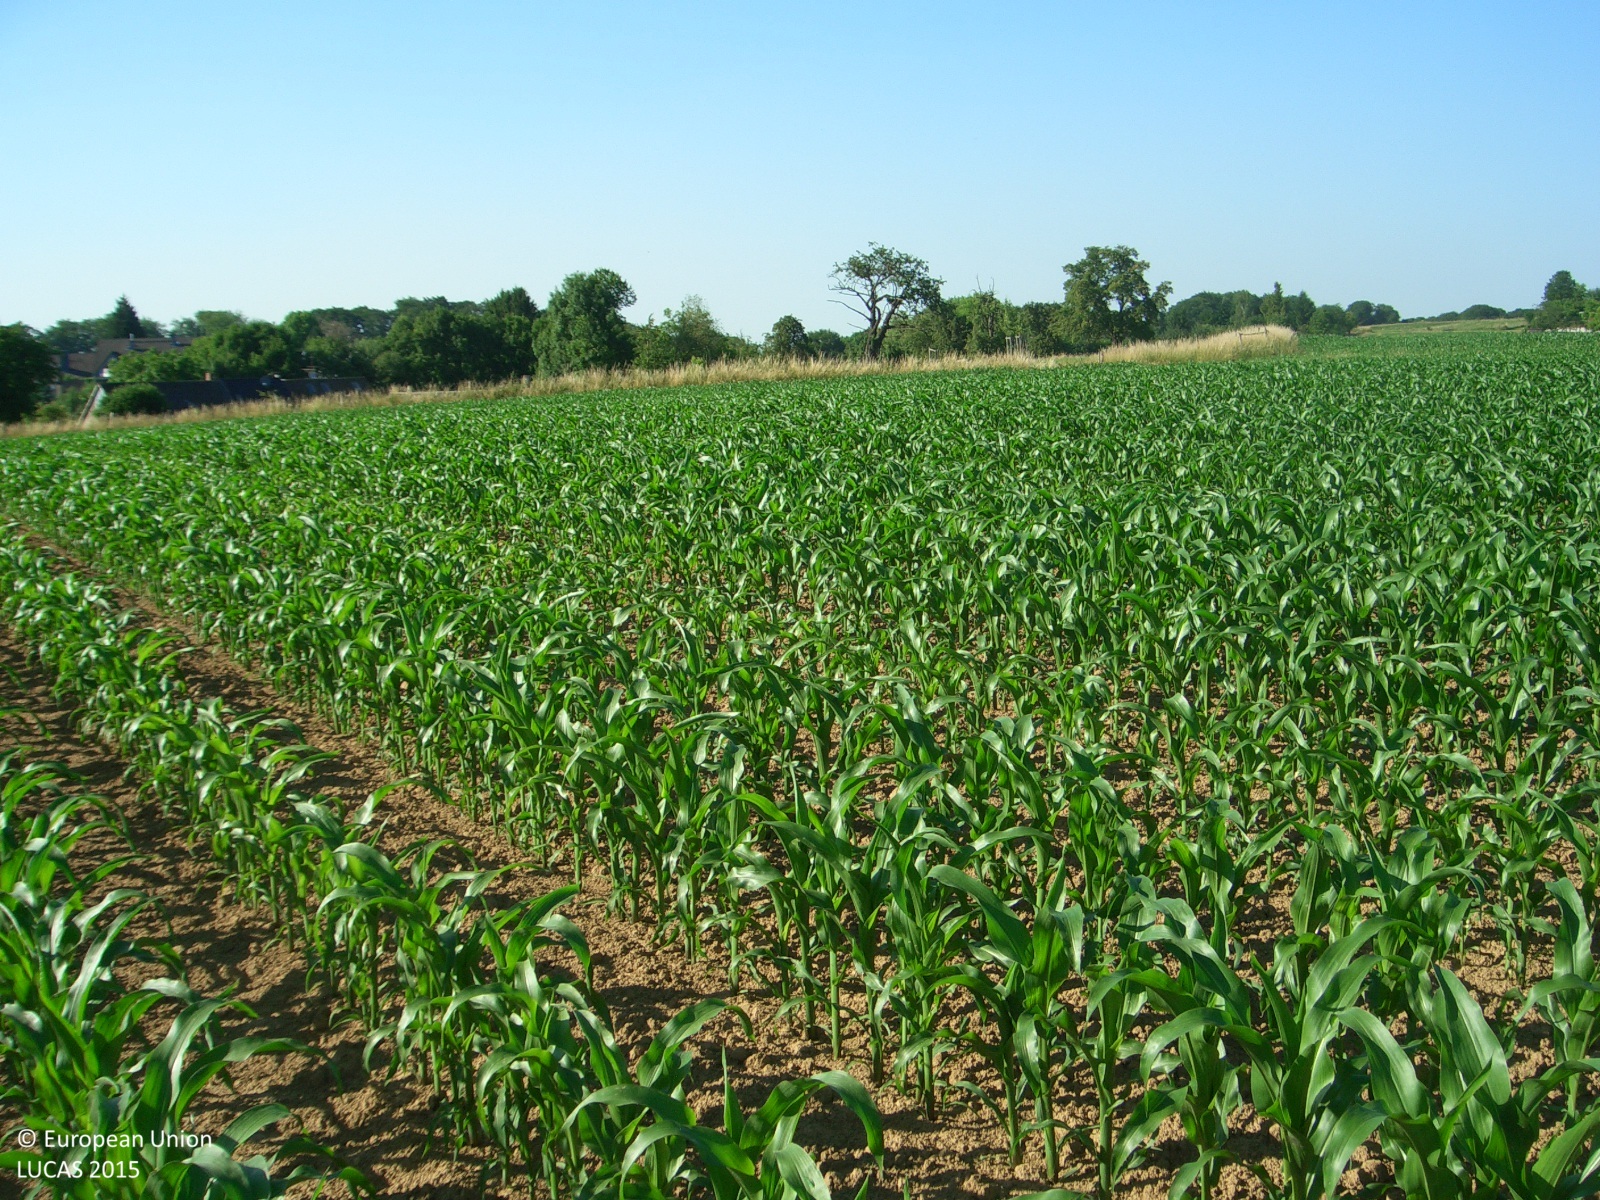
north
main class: Cropland
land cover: Maize
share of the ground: 50 - 75 %
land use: Agriculture (excluding fallow land and kitchen gardens)
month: June
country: DE
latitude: 51.1175
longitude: 7.0428
